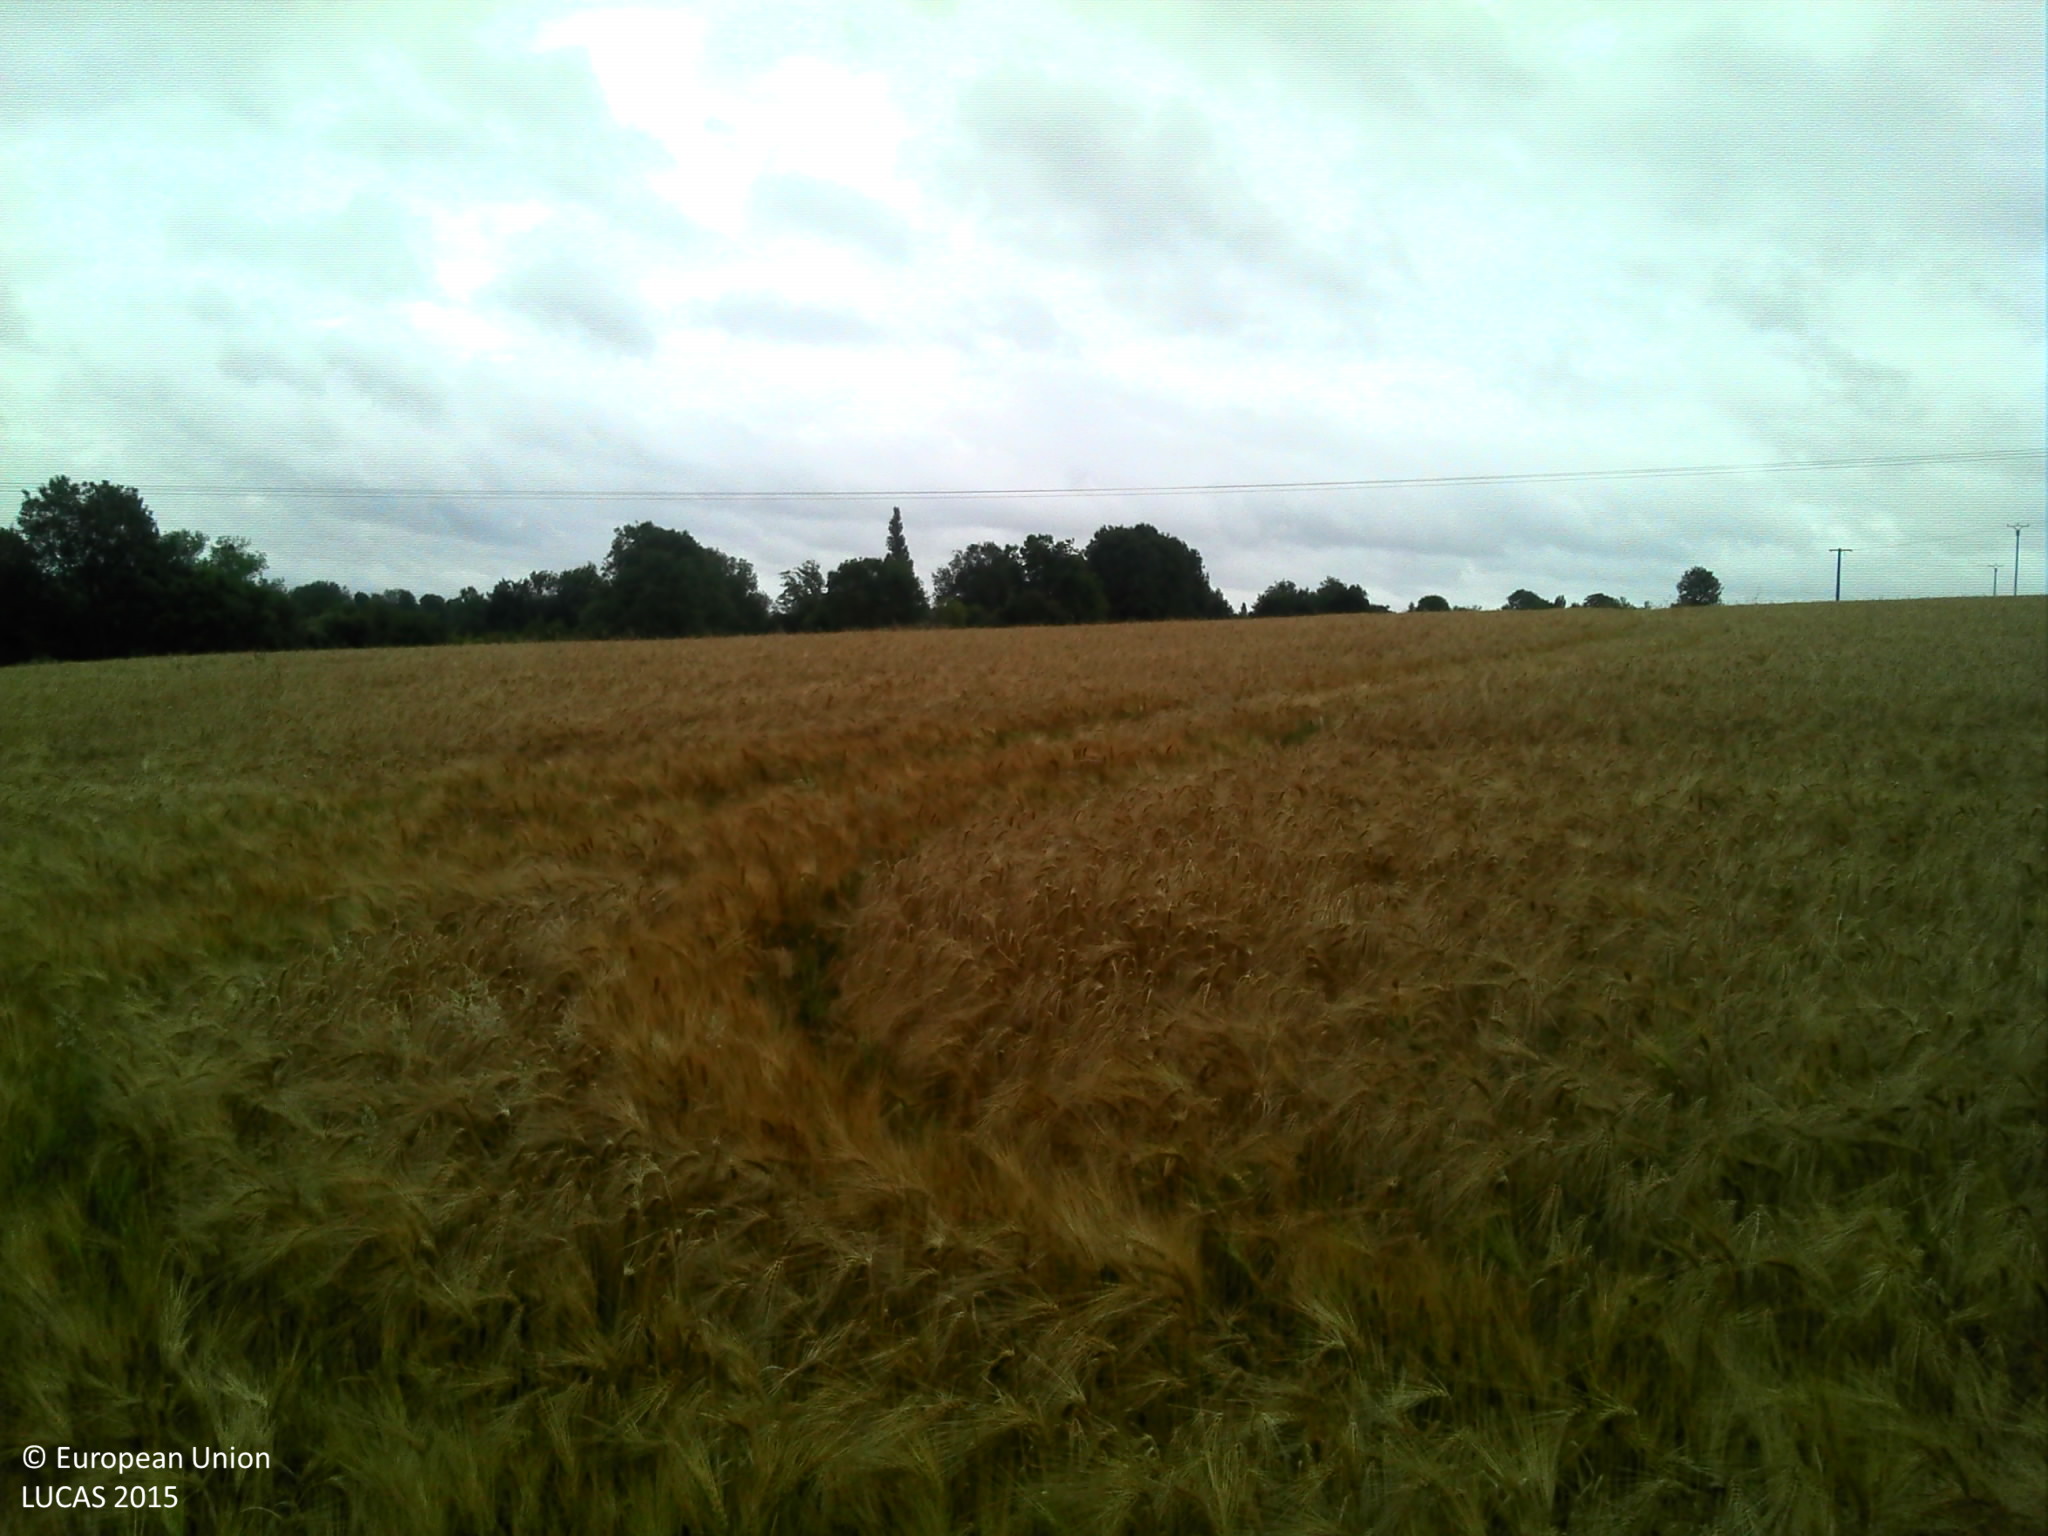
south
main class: Cropland
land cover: Barley
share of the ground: > 75 %
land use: Agriculture (excluding fallow land and kitchen gardens)
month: July
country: FR
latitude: 49.3287
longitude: 0.4374
